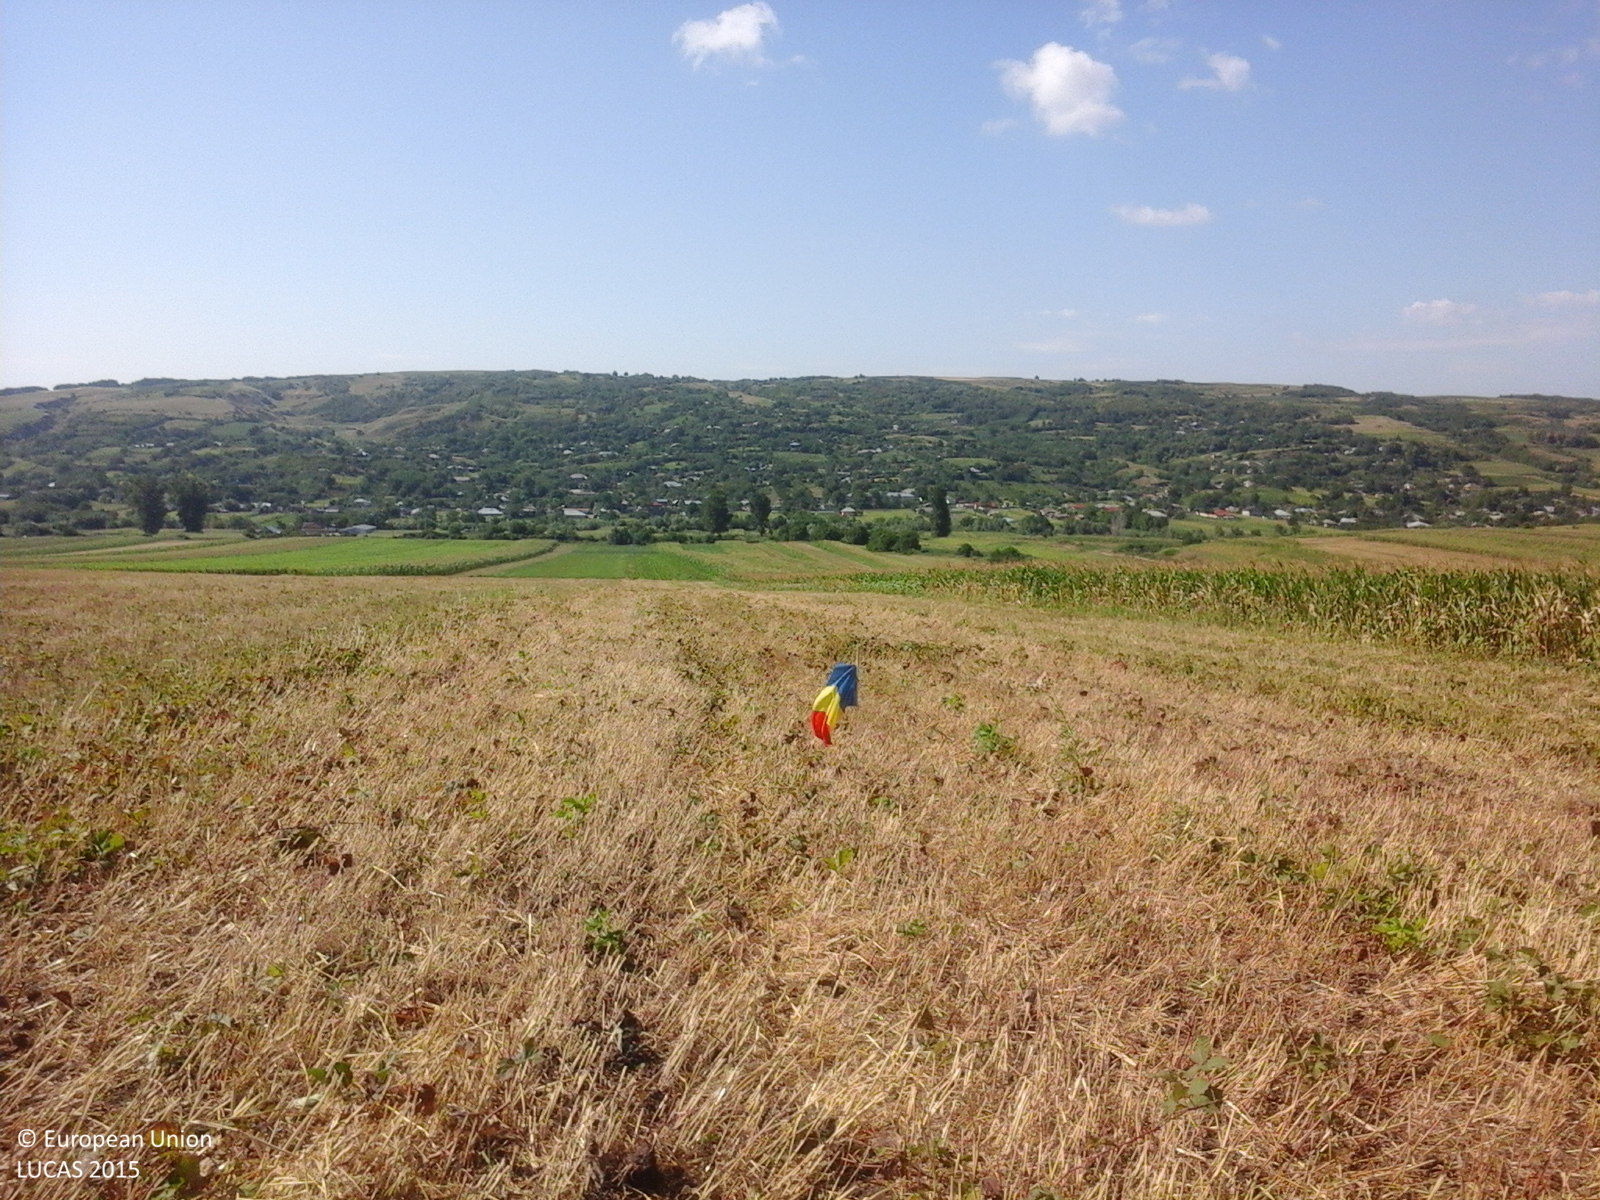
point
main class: Cropland
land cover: Common wheat
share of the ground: 50 - 75 %
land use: Agriculture (excluding fallow land and kitchen gardens)
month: July
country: RO
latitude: 46.1219
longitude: 27.7539
